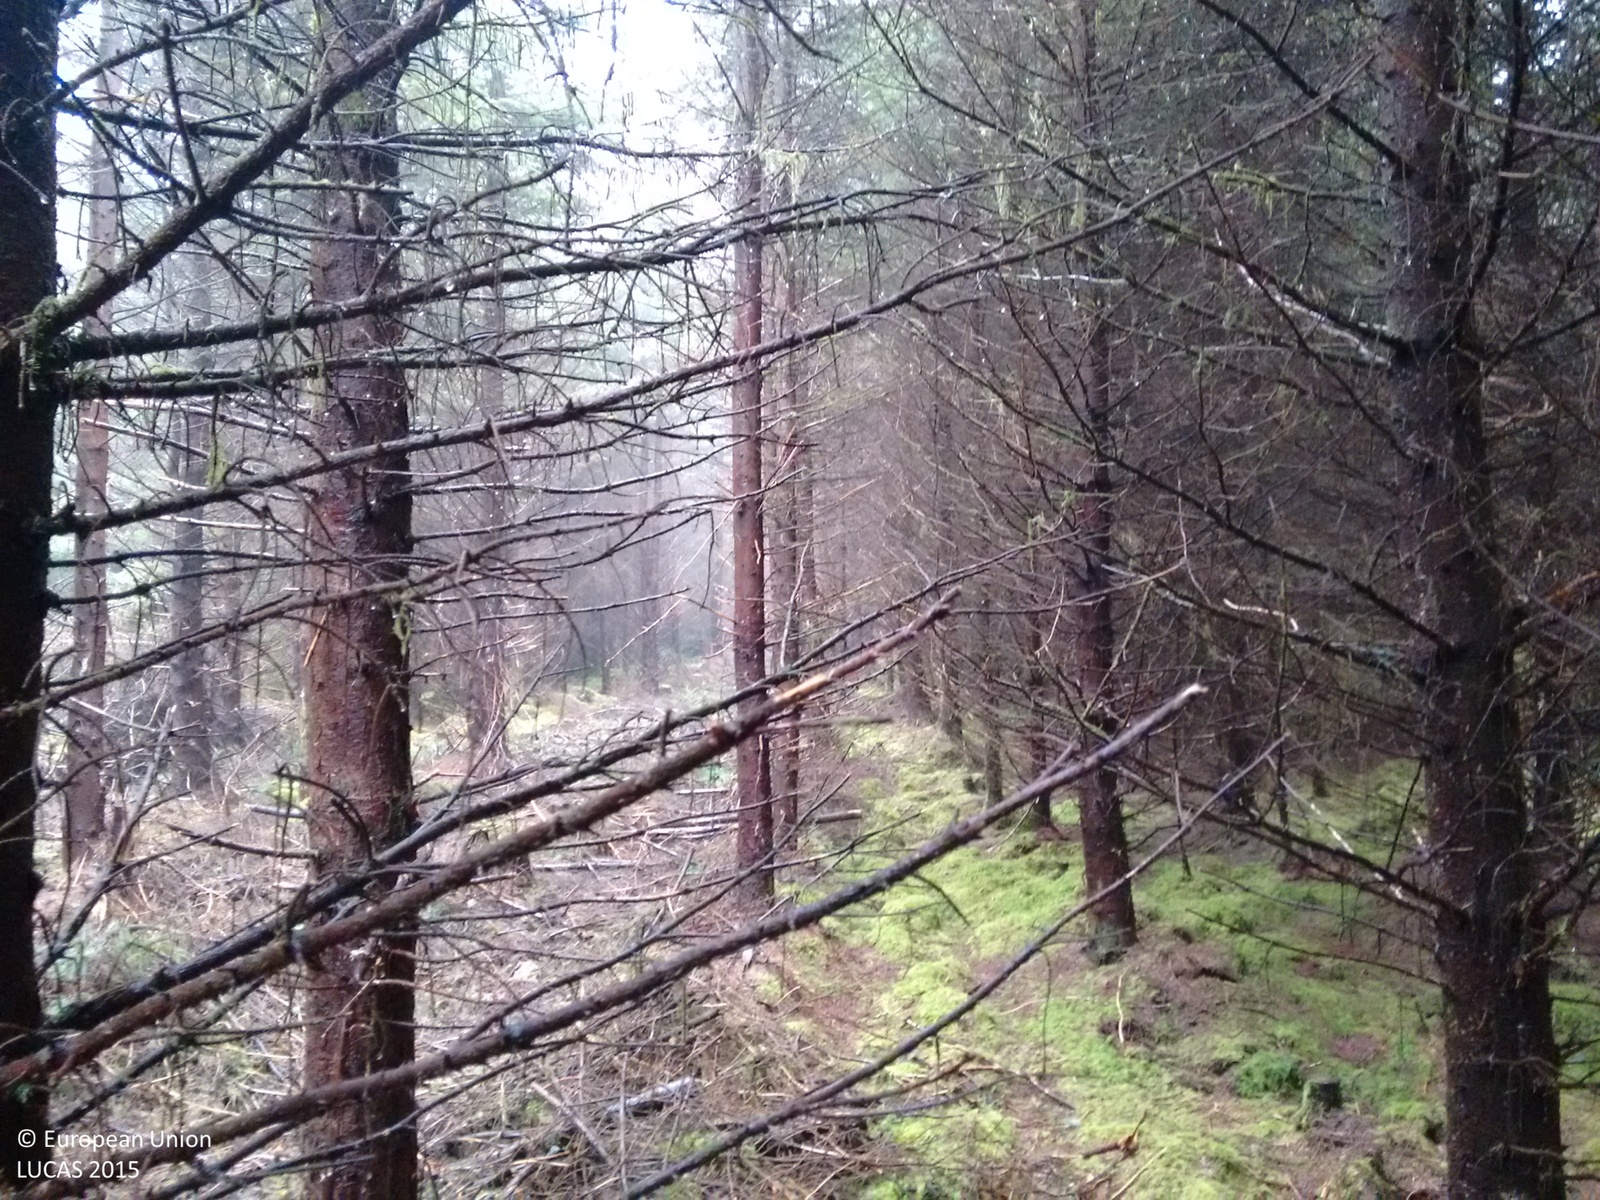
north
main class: Woodland
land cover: Spruce dominated coniferous woodland
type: exotic forest
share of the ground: > 75 %
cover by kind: coniferous forest trees 80 %, lichens and mosses 20 %
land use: Forestry
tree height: > 5 m
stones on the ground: < 10 %
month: November
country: IE
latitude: 54.3257
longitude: -8.1216
